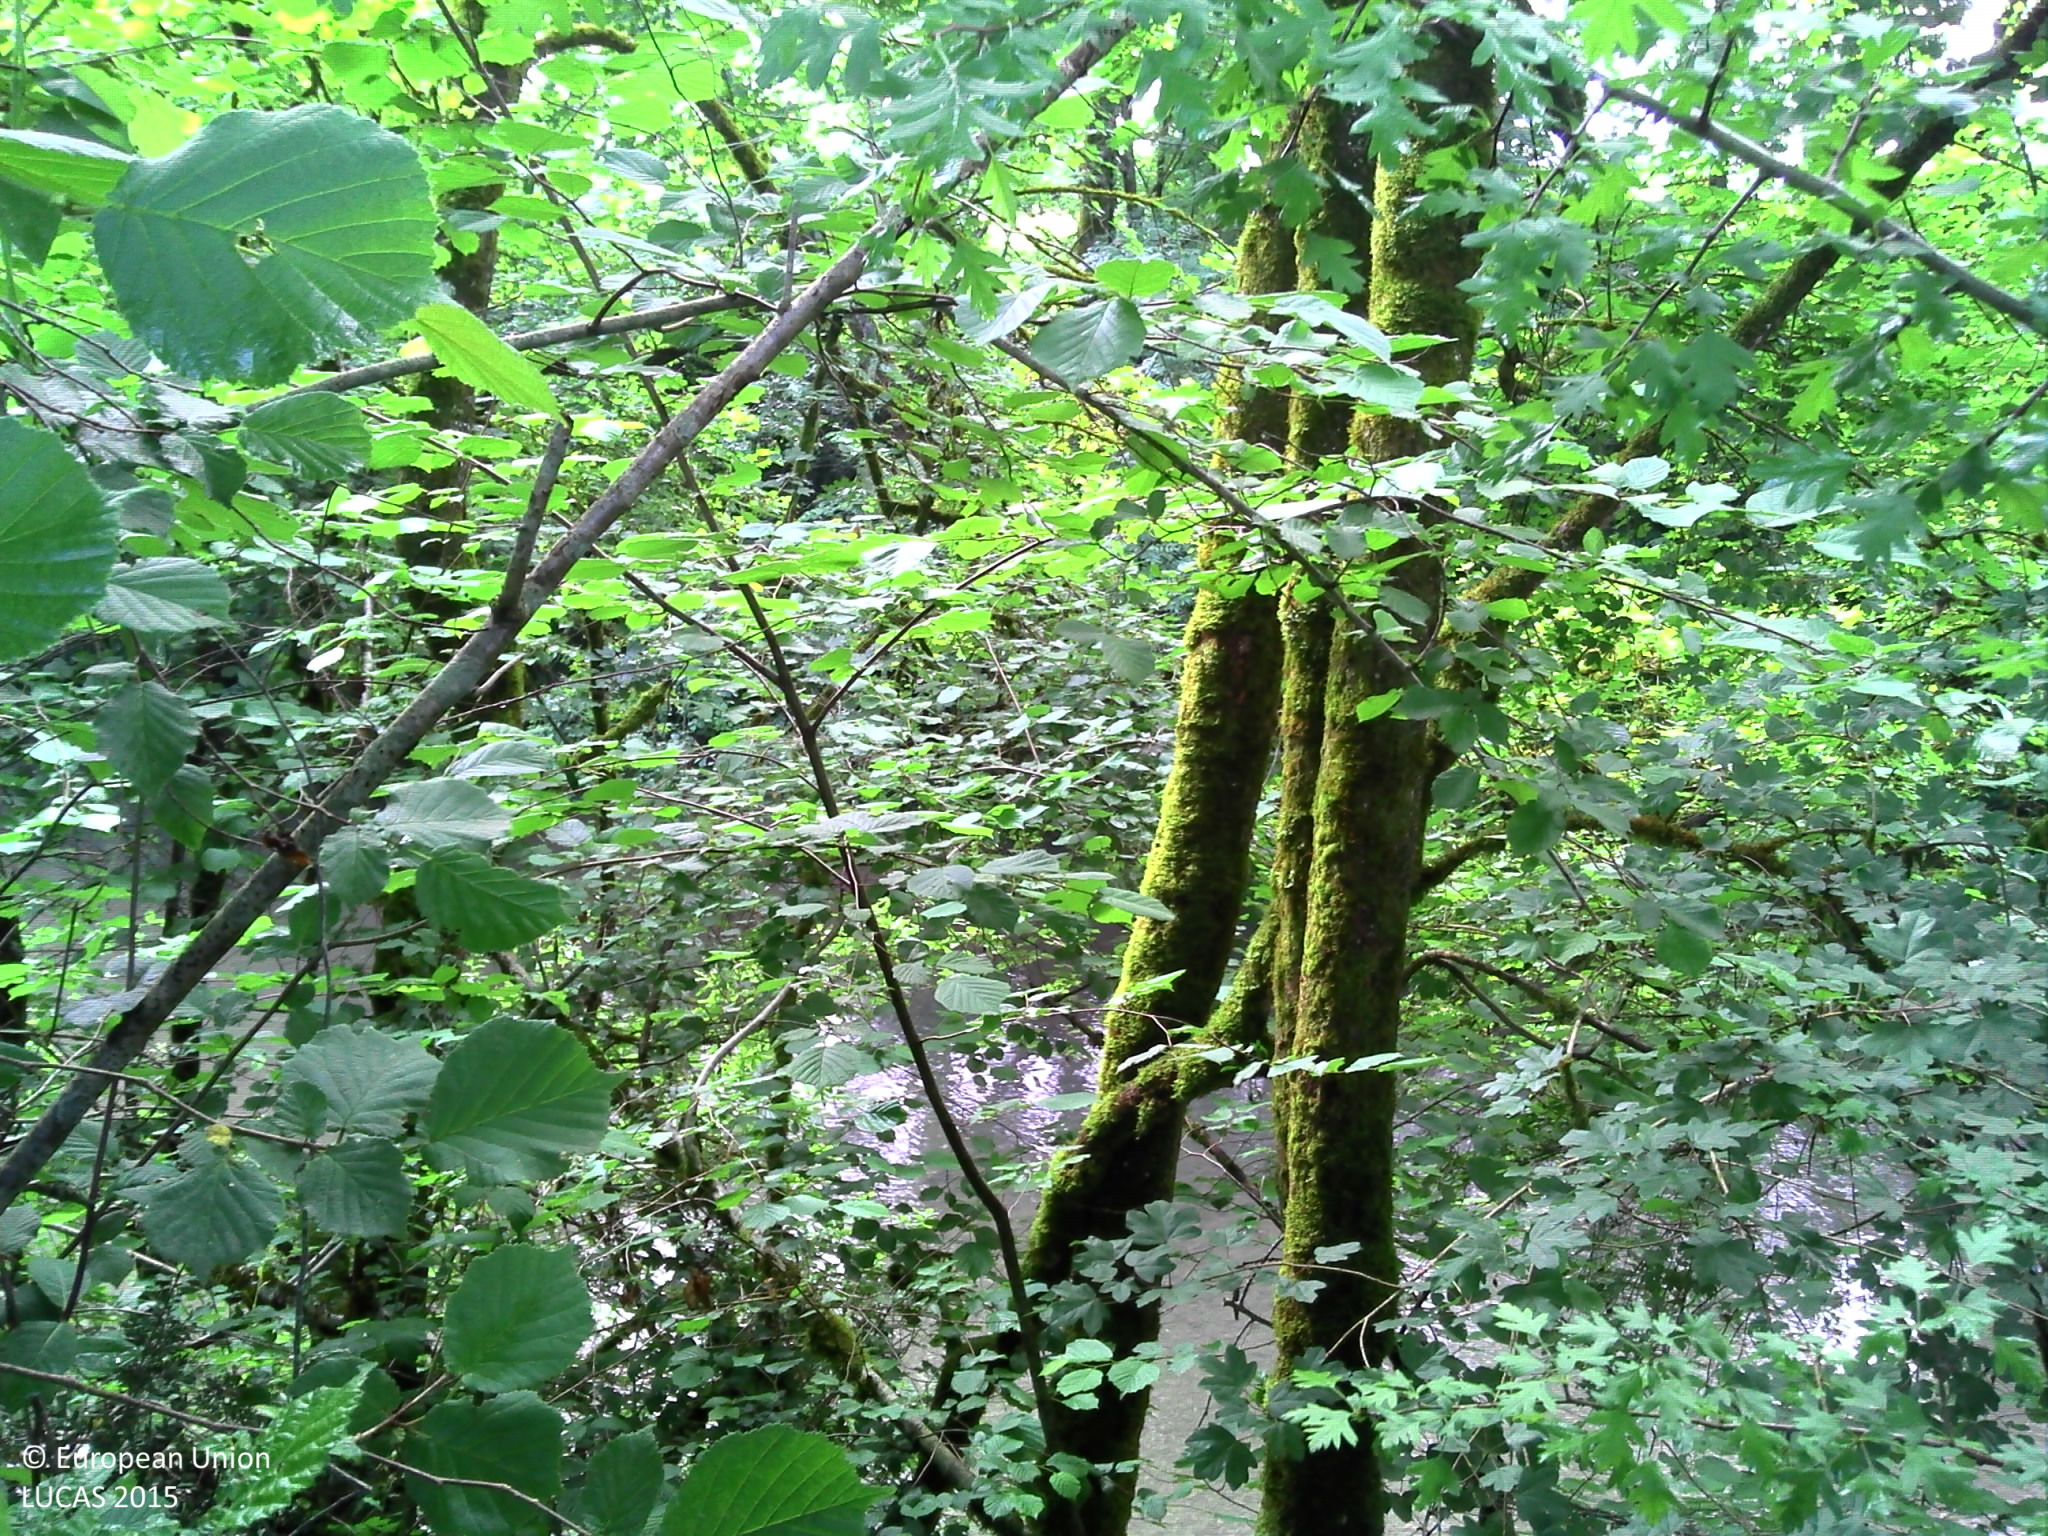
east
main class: Woodland
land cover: Broadleaved woodland
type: acidophilous oak and oak-birch forest
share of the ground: > 75 %
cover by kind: broadleaved forest trees 70 %, shrubs 10 %, herbaceous plants 10 %, lichens and mosses 10 %
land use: Forestry
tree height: > 5 m
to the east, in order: Broadleaved woodland; Inland fresh running water; Broadleaved woodland; Artificial constructions in urban areas; Grassland without tree/shrub cover; Lucerne; Grass margins; Fences; Grass margins; Maize
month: June
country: FR
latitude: 43.2183
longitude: -0.6570
